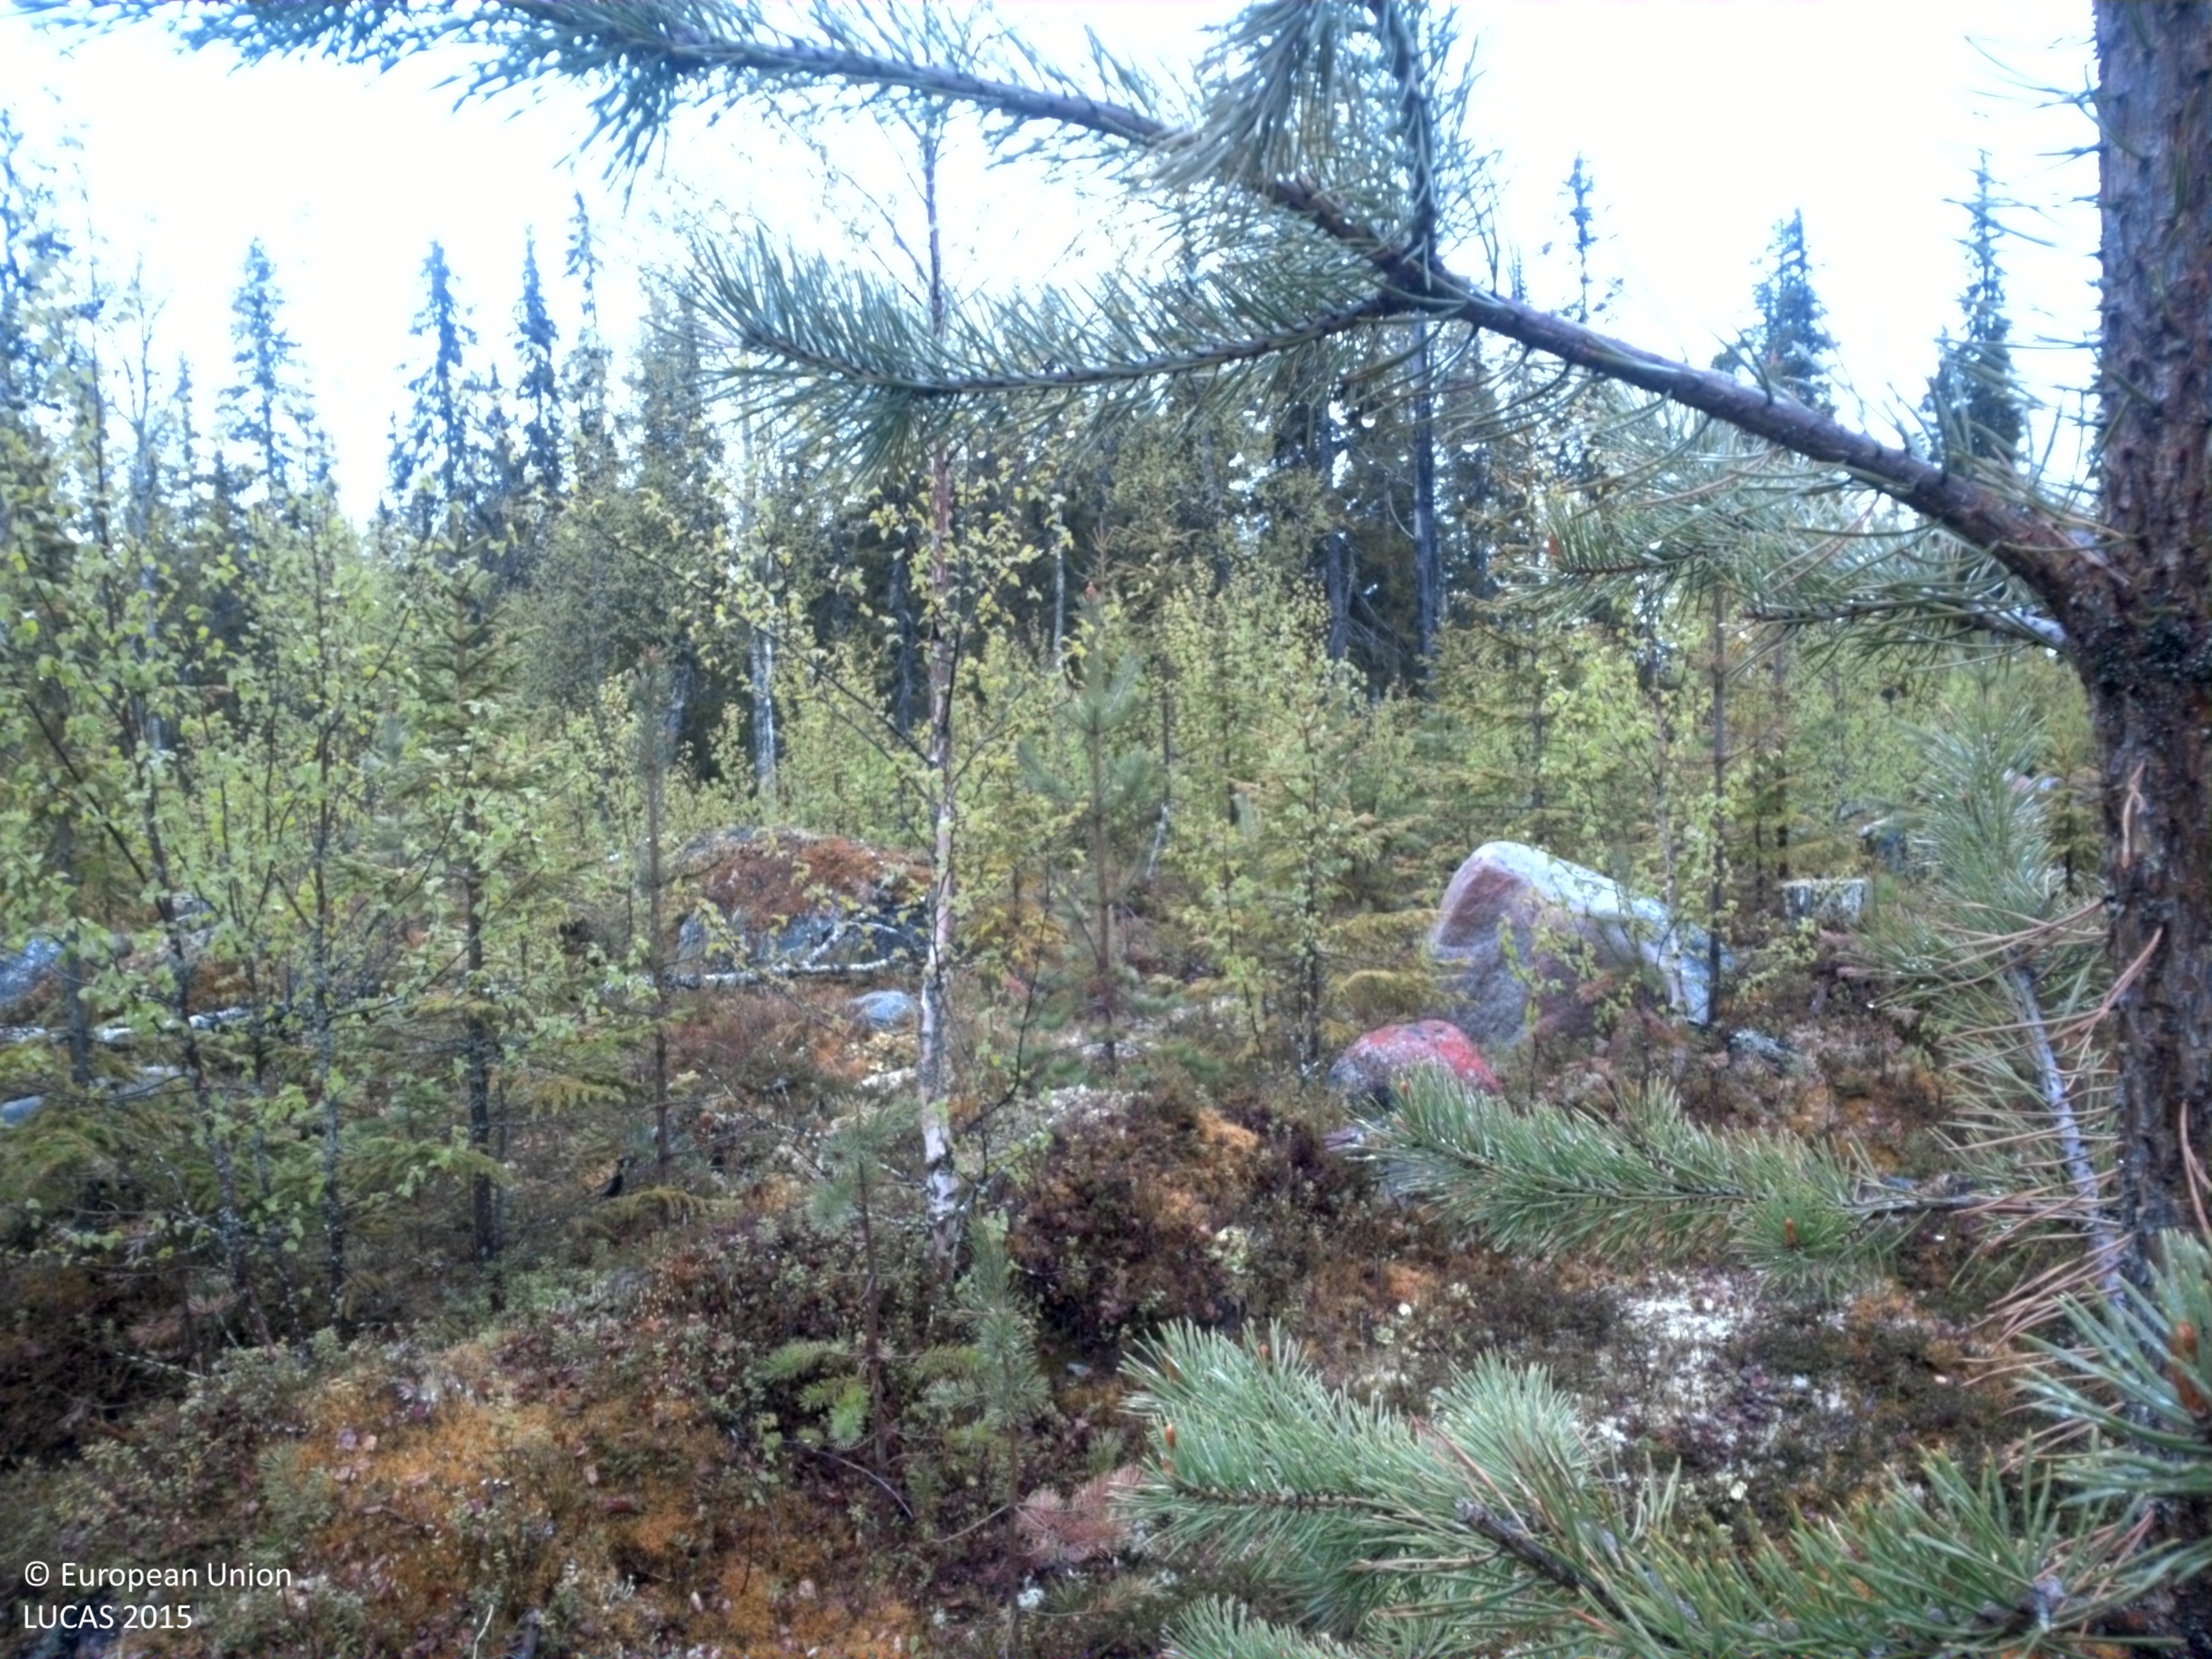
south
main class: Woodland
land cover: Pine dominated mixed woodland
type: boreal forest
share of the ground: 25 - 50 %
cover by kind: coniferous forest trees 30 %, herbaceous plants 25 %, broadleaved forest trees 15 %, lichens and mosses 15 %, unconsolidated bare surface 10 %, shrubs 5 %
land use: Forestry
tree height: < 5 m
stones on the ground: 25 - 50 %
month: June
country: SE
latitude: 64.4420
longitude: 17.4256
